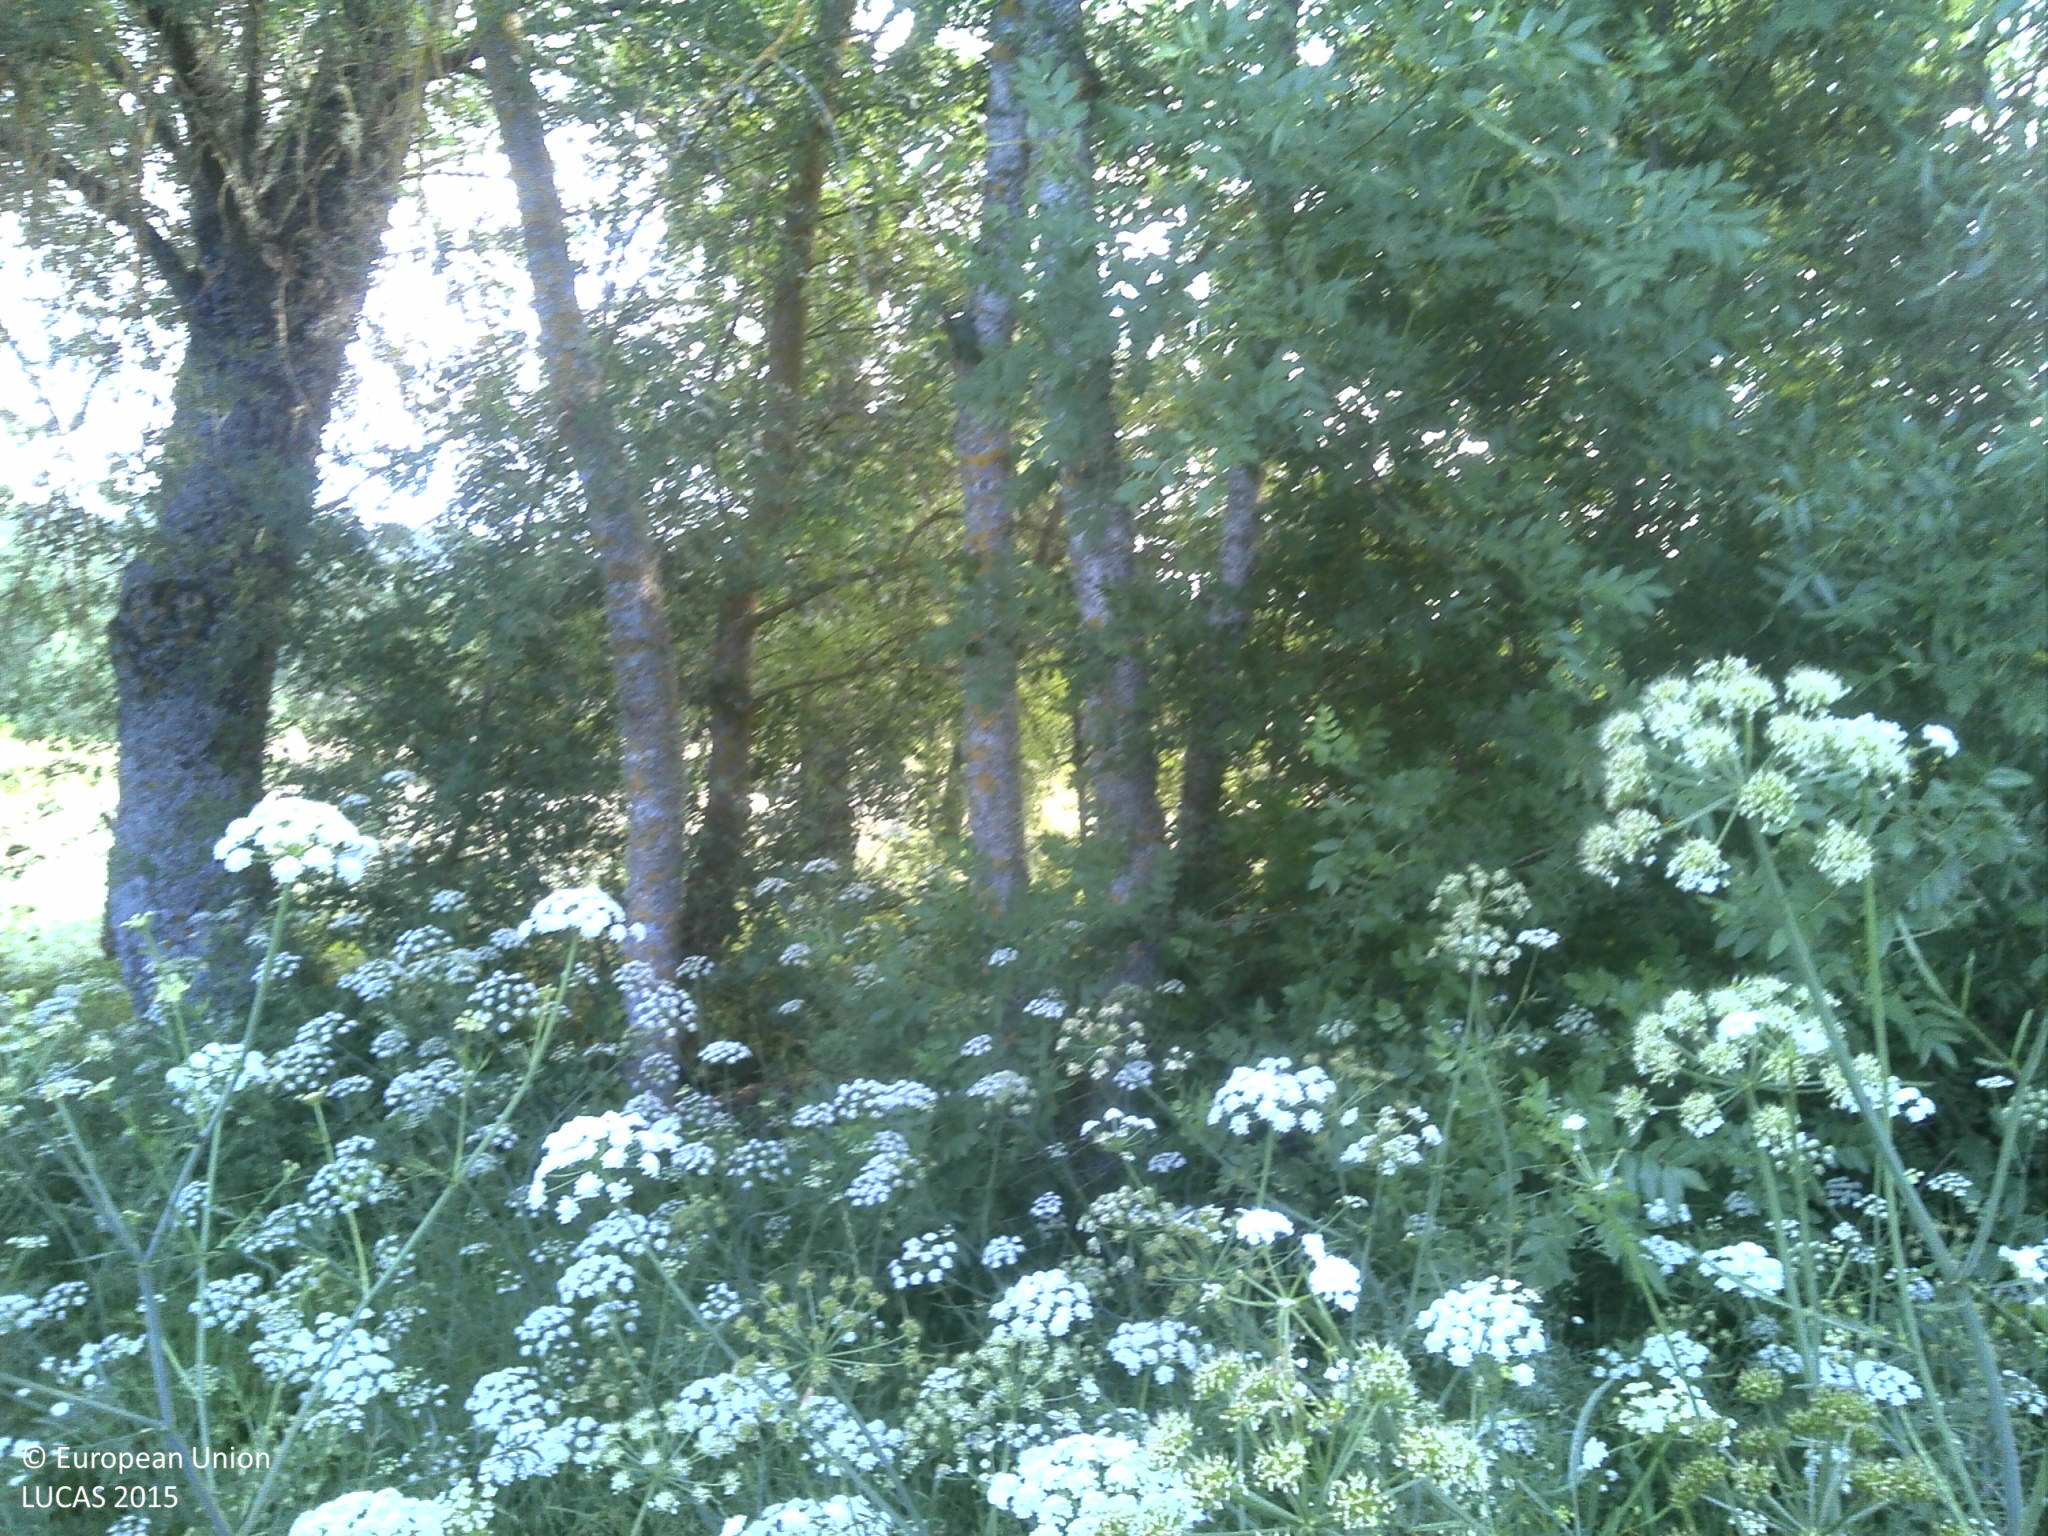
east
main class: Grassland
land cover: Spontaneously vegetated surfaces
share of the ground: 50 - 75 %
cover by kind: herbaceous plants 80 %, unconsolidated bare surface 20 %
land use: Fallow land
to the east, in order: Spontaneously vegetated surfaces; Abandoned hedges; Spontaneously vegetated surfaces; Dry stone walls; Grassland with sparse tree/shrub cover; Abandoned hedges; Dry stone walls; Tracks; Dry stone walls; Abandoned hedges; Spontaneously vegetated surfaces; Dry stone walls; Abandoned hedges; Grassland without tree/shrub cover; Shrubland without tree cover
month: June
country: PT
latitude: 40.4650
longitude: -7.1193
